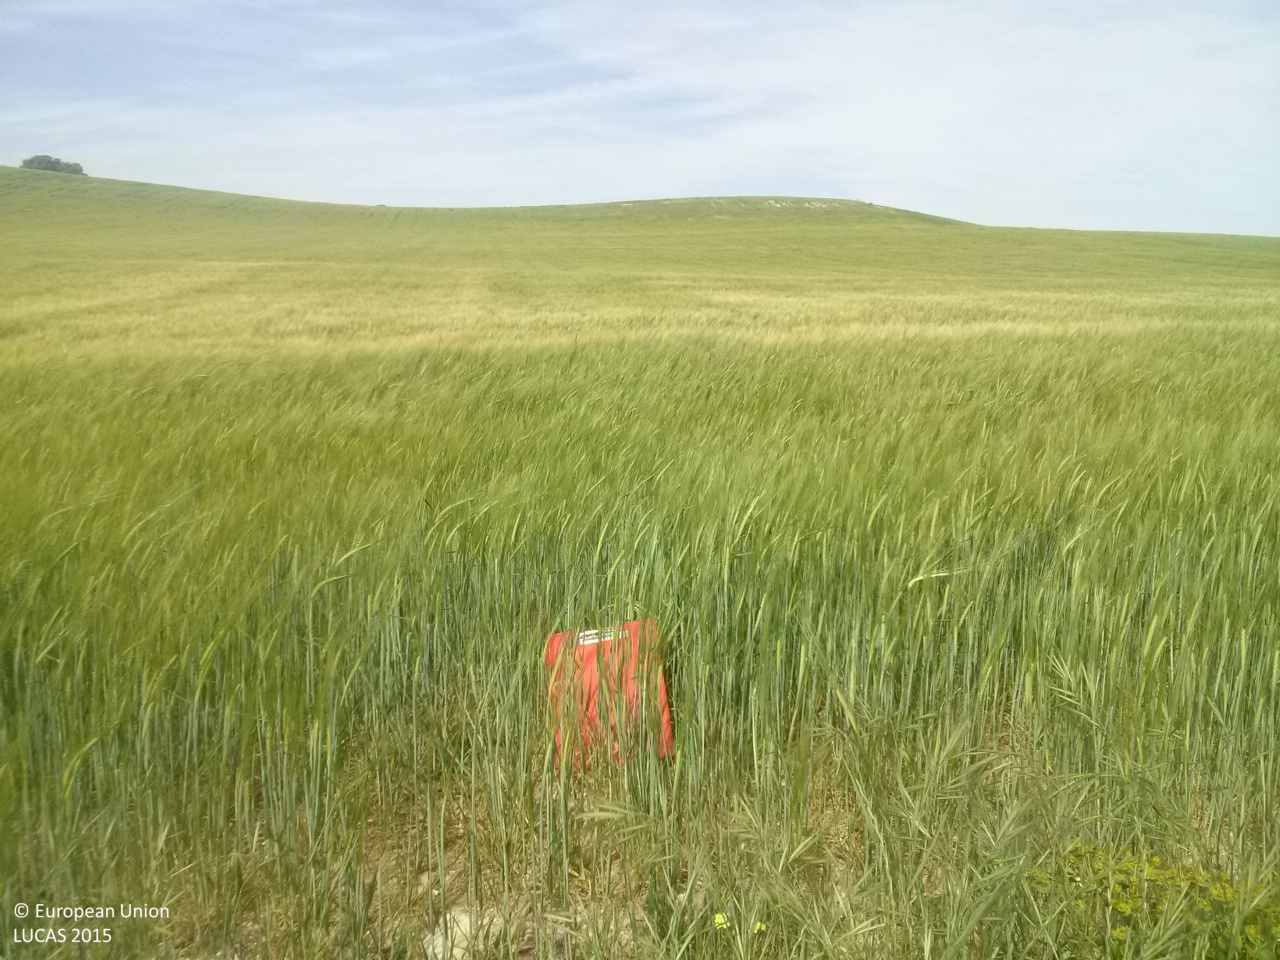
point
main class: Cropland
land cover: Barley
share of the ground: > 75 %
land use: Agriculture (excluding fallow land and kitchen gardens)
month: May
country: ES
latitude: 39.7906
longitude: -2.6643
